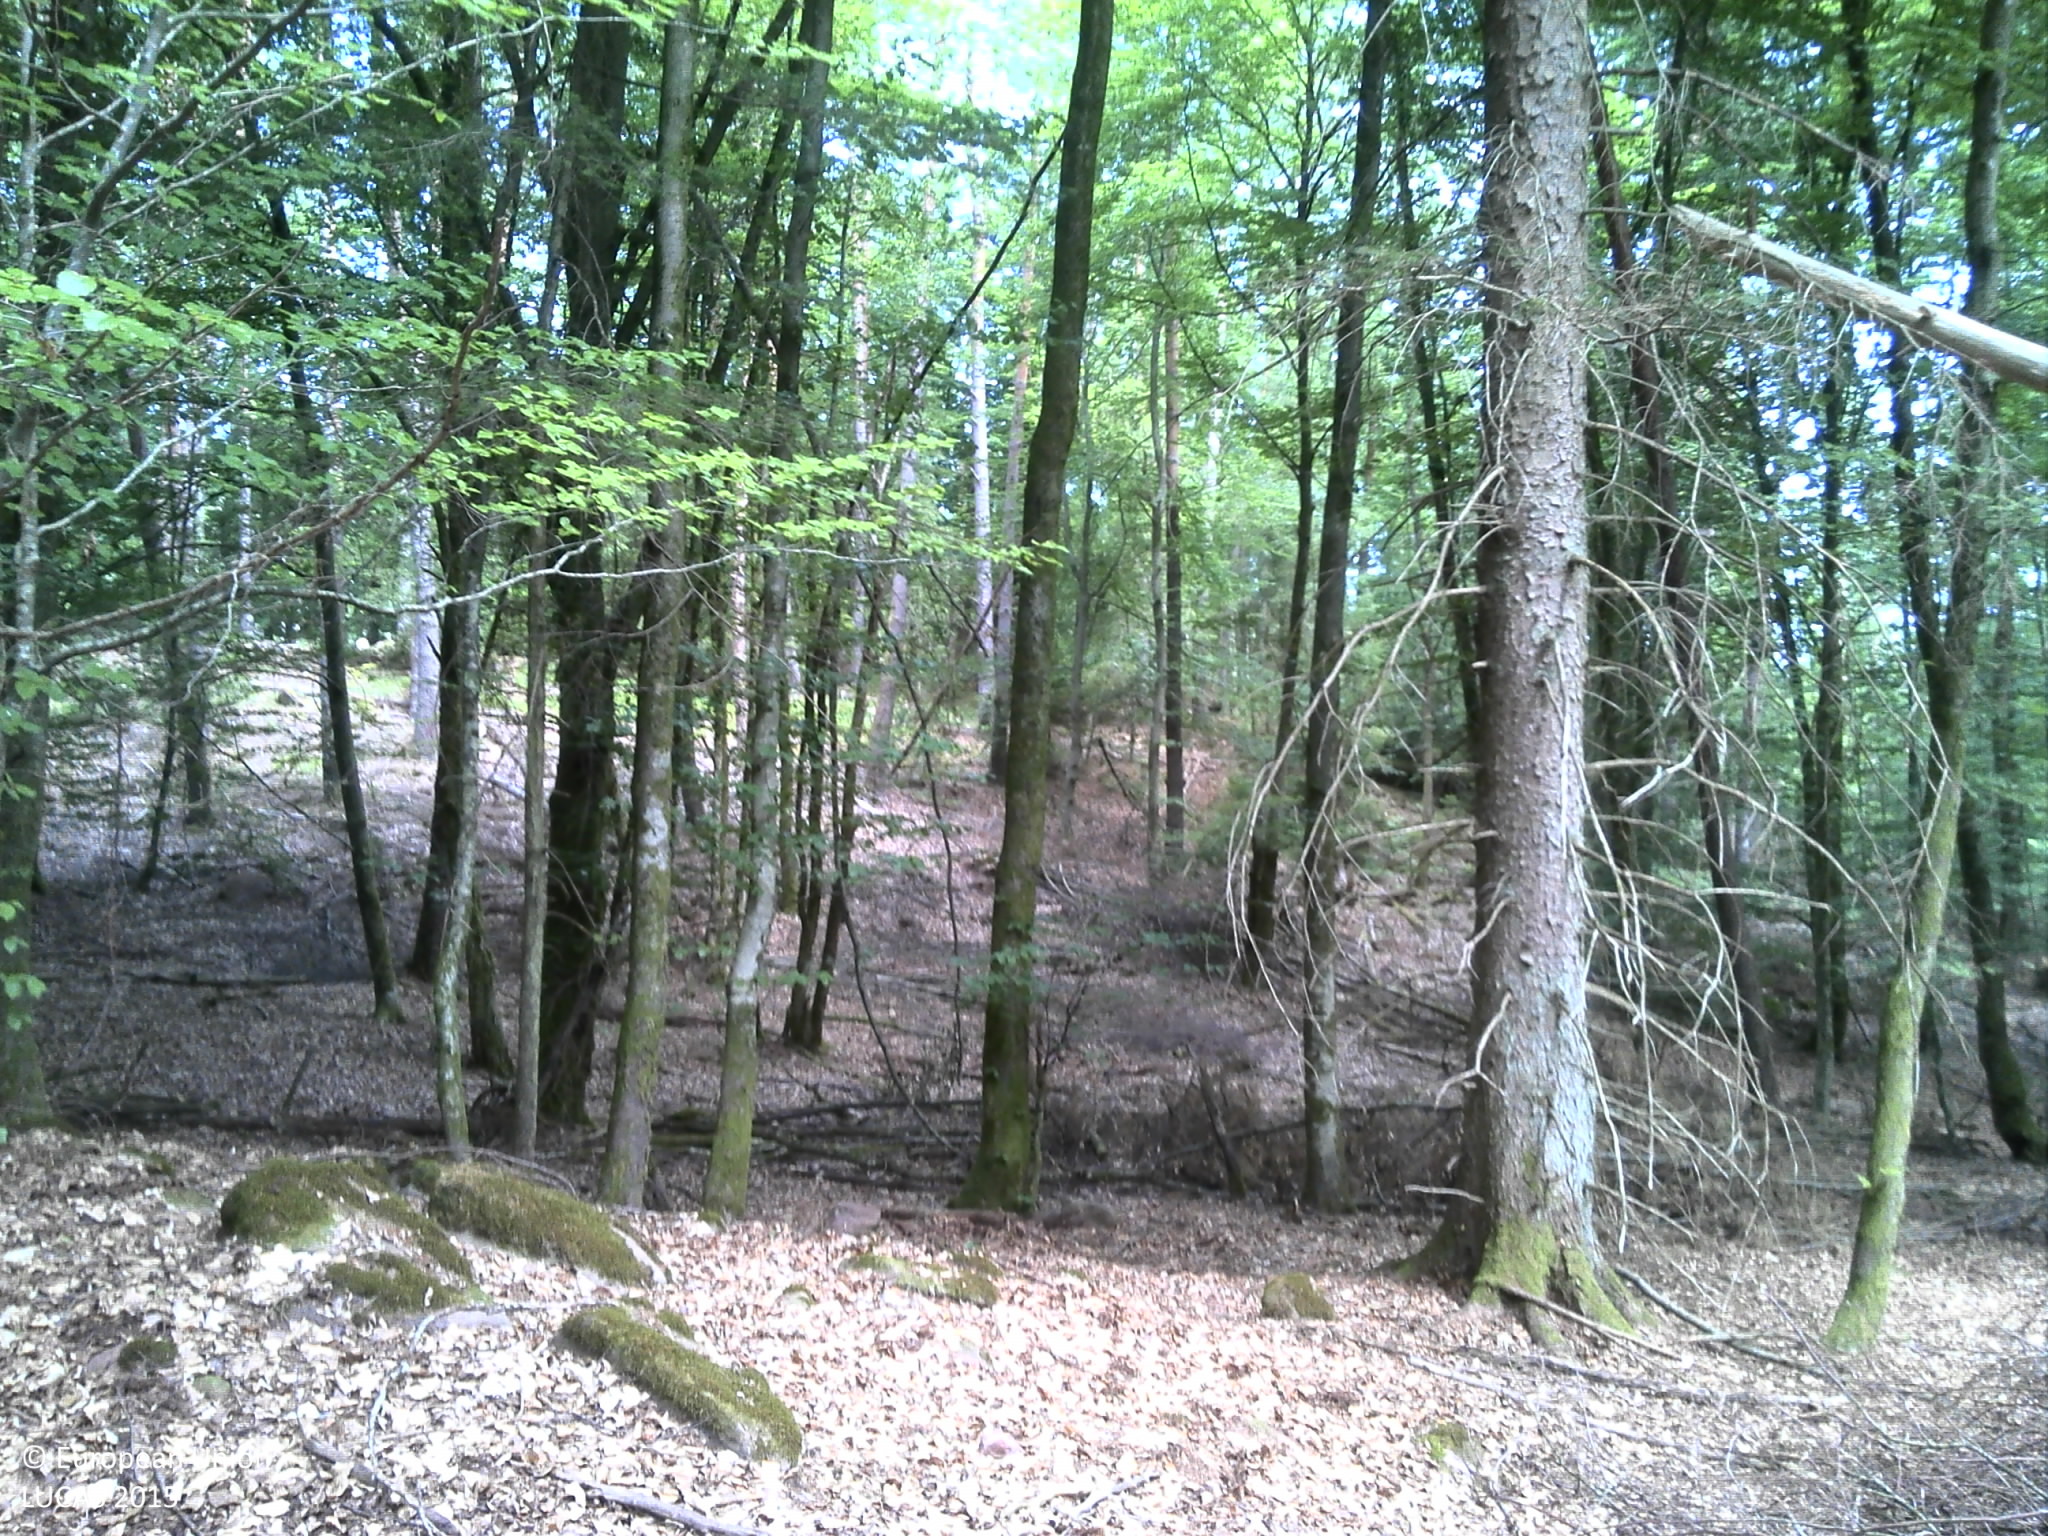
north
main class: Woodland
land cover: Broadleaved woodland
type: mesophytic deciduous forest
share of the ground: > 75 %
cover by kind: broadleaved forest trees 85 %, coniferous forest trees 5 %, lichens and mosses 5 %, unconsolidated bare surface 5 %
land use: Forestry
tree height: > 5 m
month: July
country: FR
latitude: 48.9866
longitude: 7.4725
